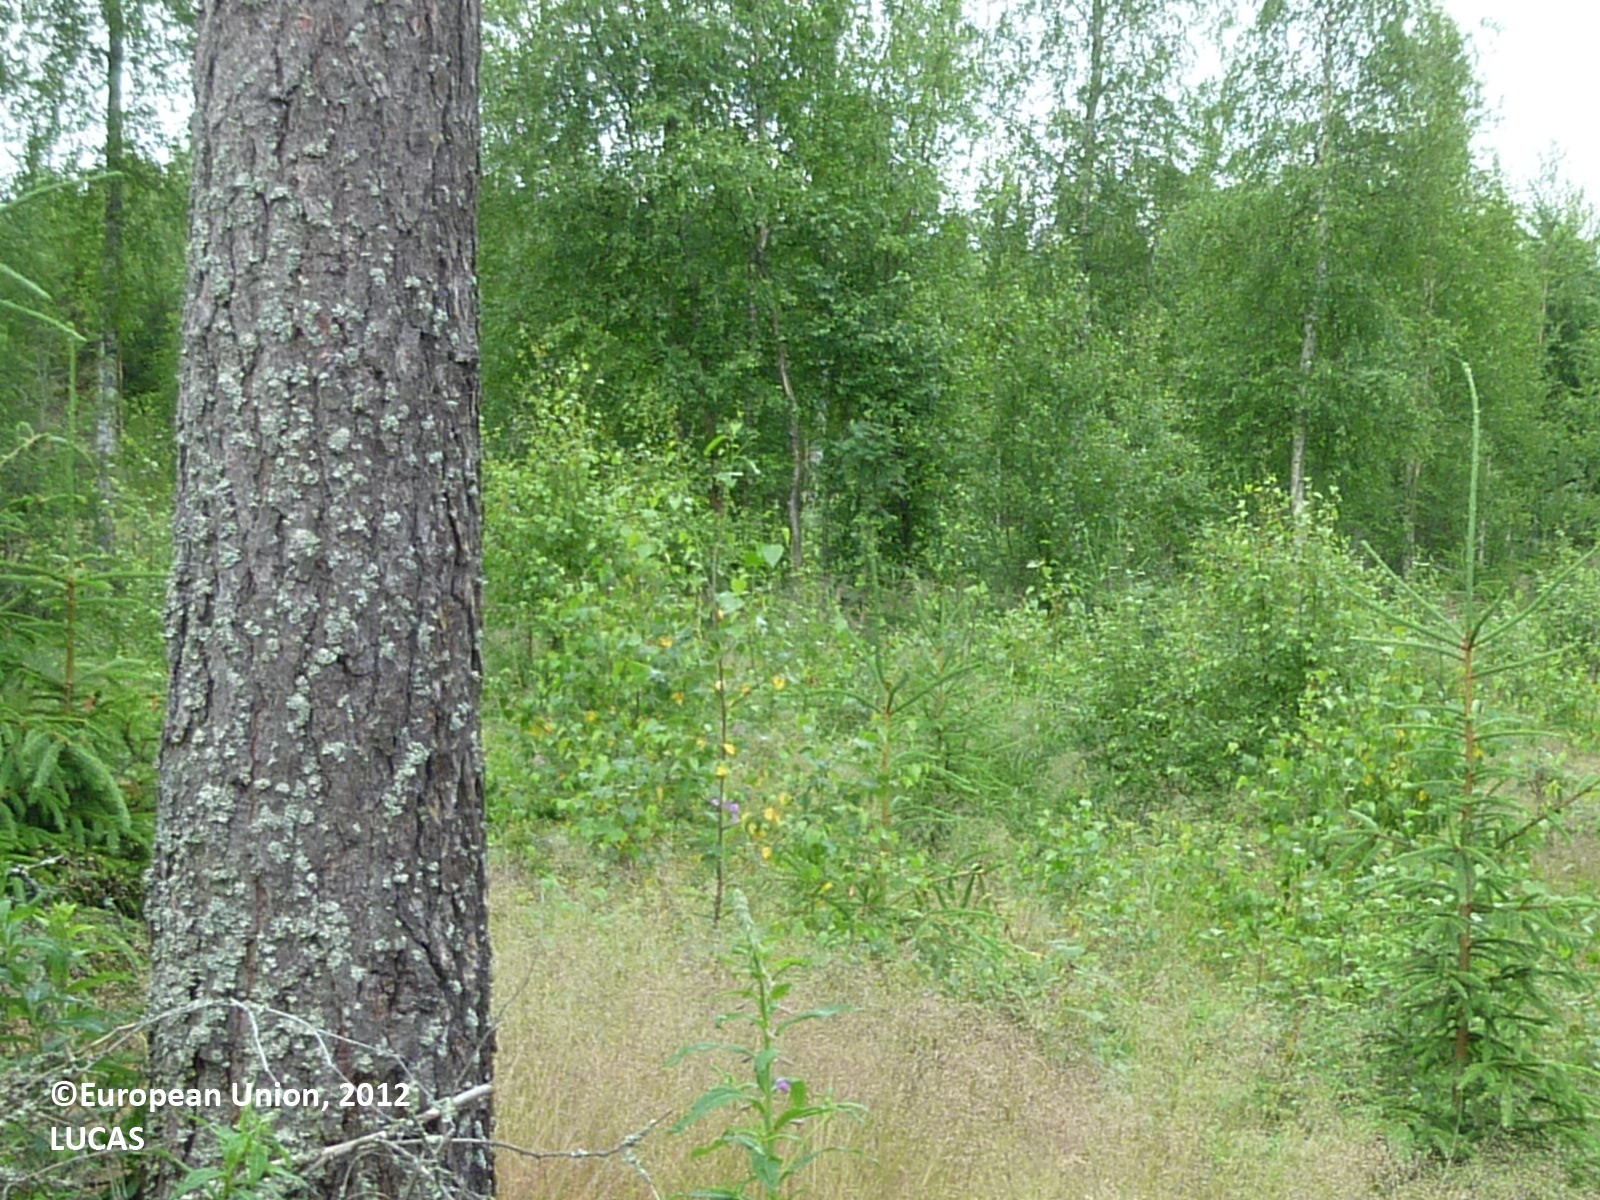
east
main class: Woodland
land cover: Broadleaved woodland
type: boreal forest
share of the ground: > 75 %
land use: Forestry
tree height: > 5 m
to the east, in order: Broadleaved woodland; Pine dominated mixed woodland; Spruce dominated coniferous woodland
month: July
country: FI
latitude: 61.4741
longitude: 22.2044
